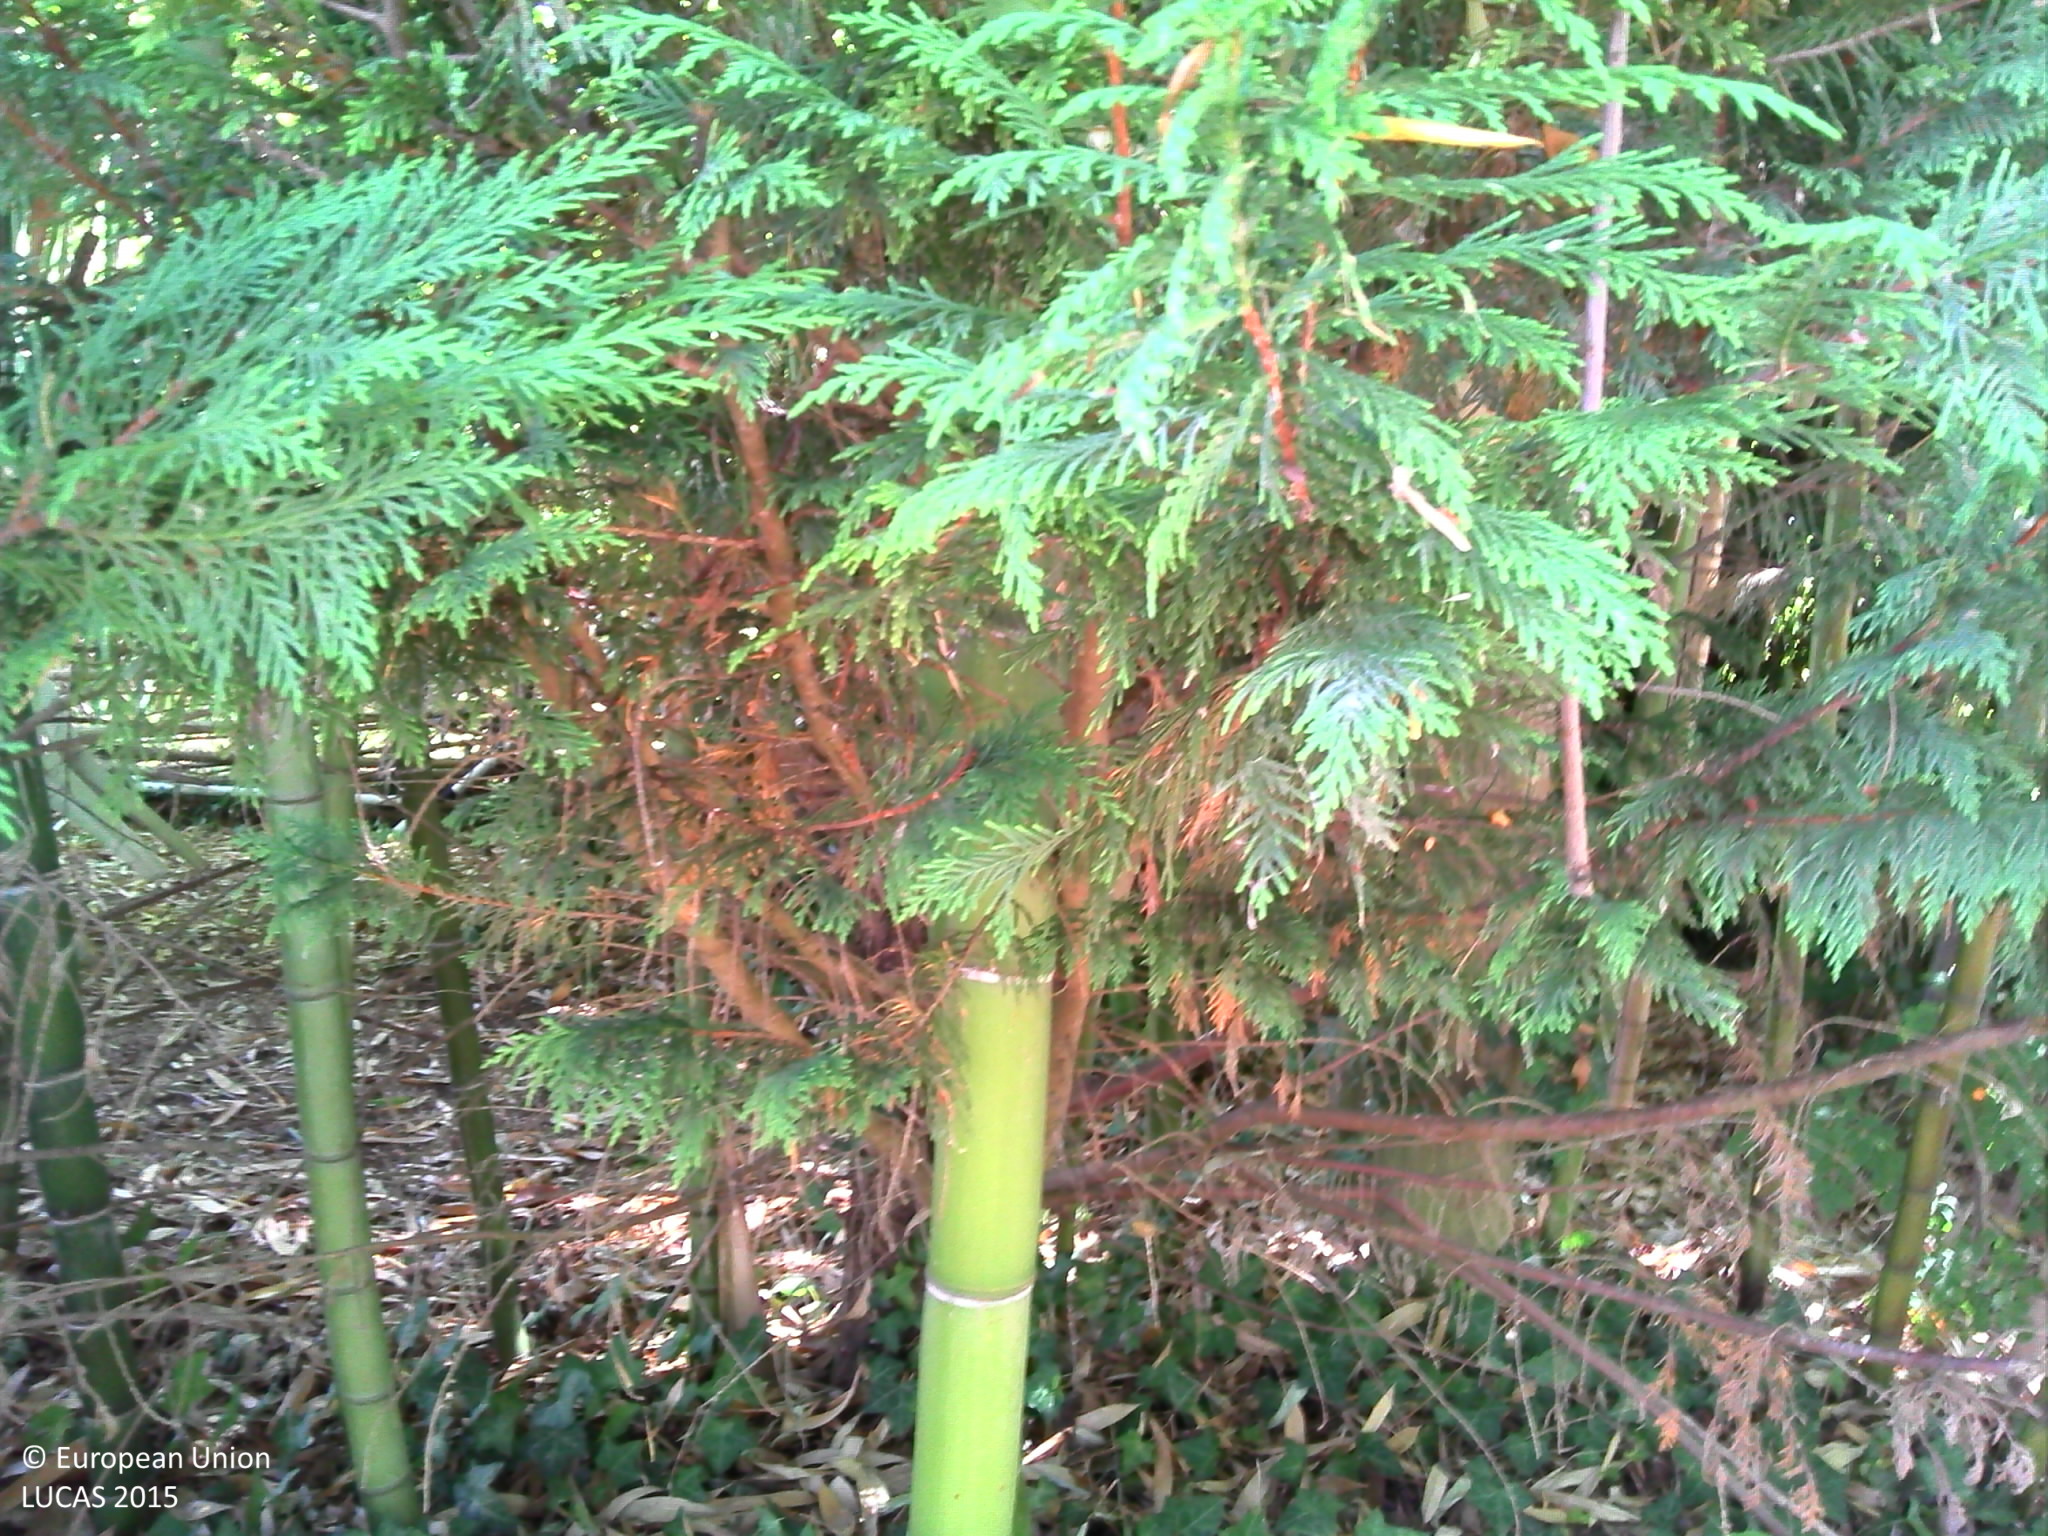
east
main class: Grassland
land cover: Grassland with sparse tree/shrub cover
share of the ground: > 75 %
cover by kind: herbaceous plants 90 %, broadleaved forest trees 5 %, shrubs 5 %
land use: Residential
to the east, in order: Grassland with sparse tree/shrub cover; Broadleaved woodland; Artificial constructions in urban areas; Spontaneously vegetated surfaces
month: August
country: FR
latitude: 44.1692
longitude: 1.5583
